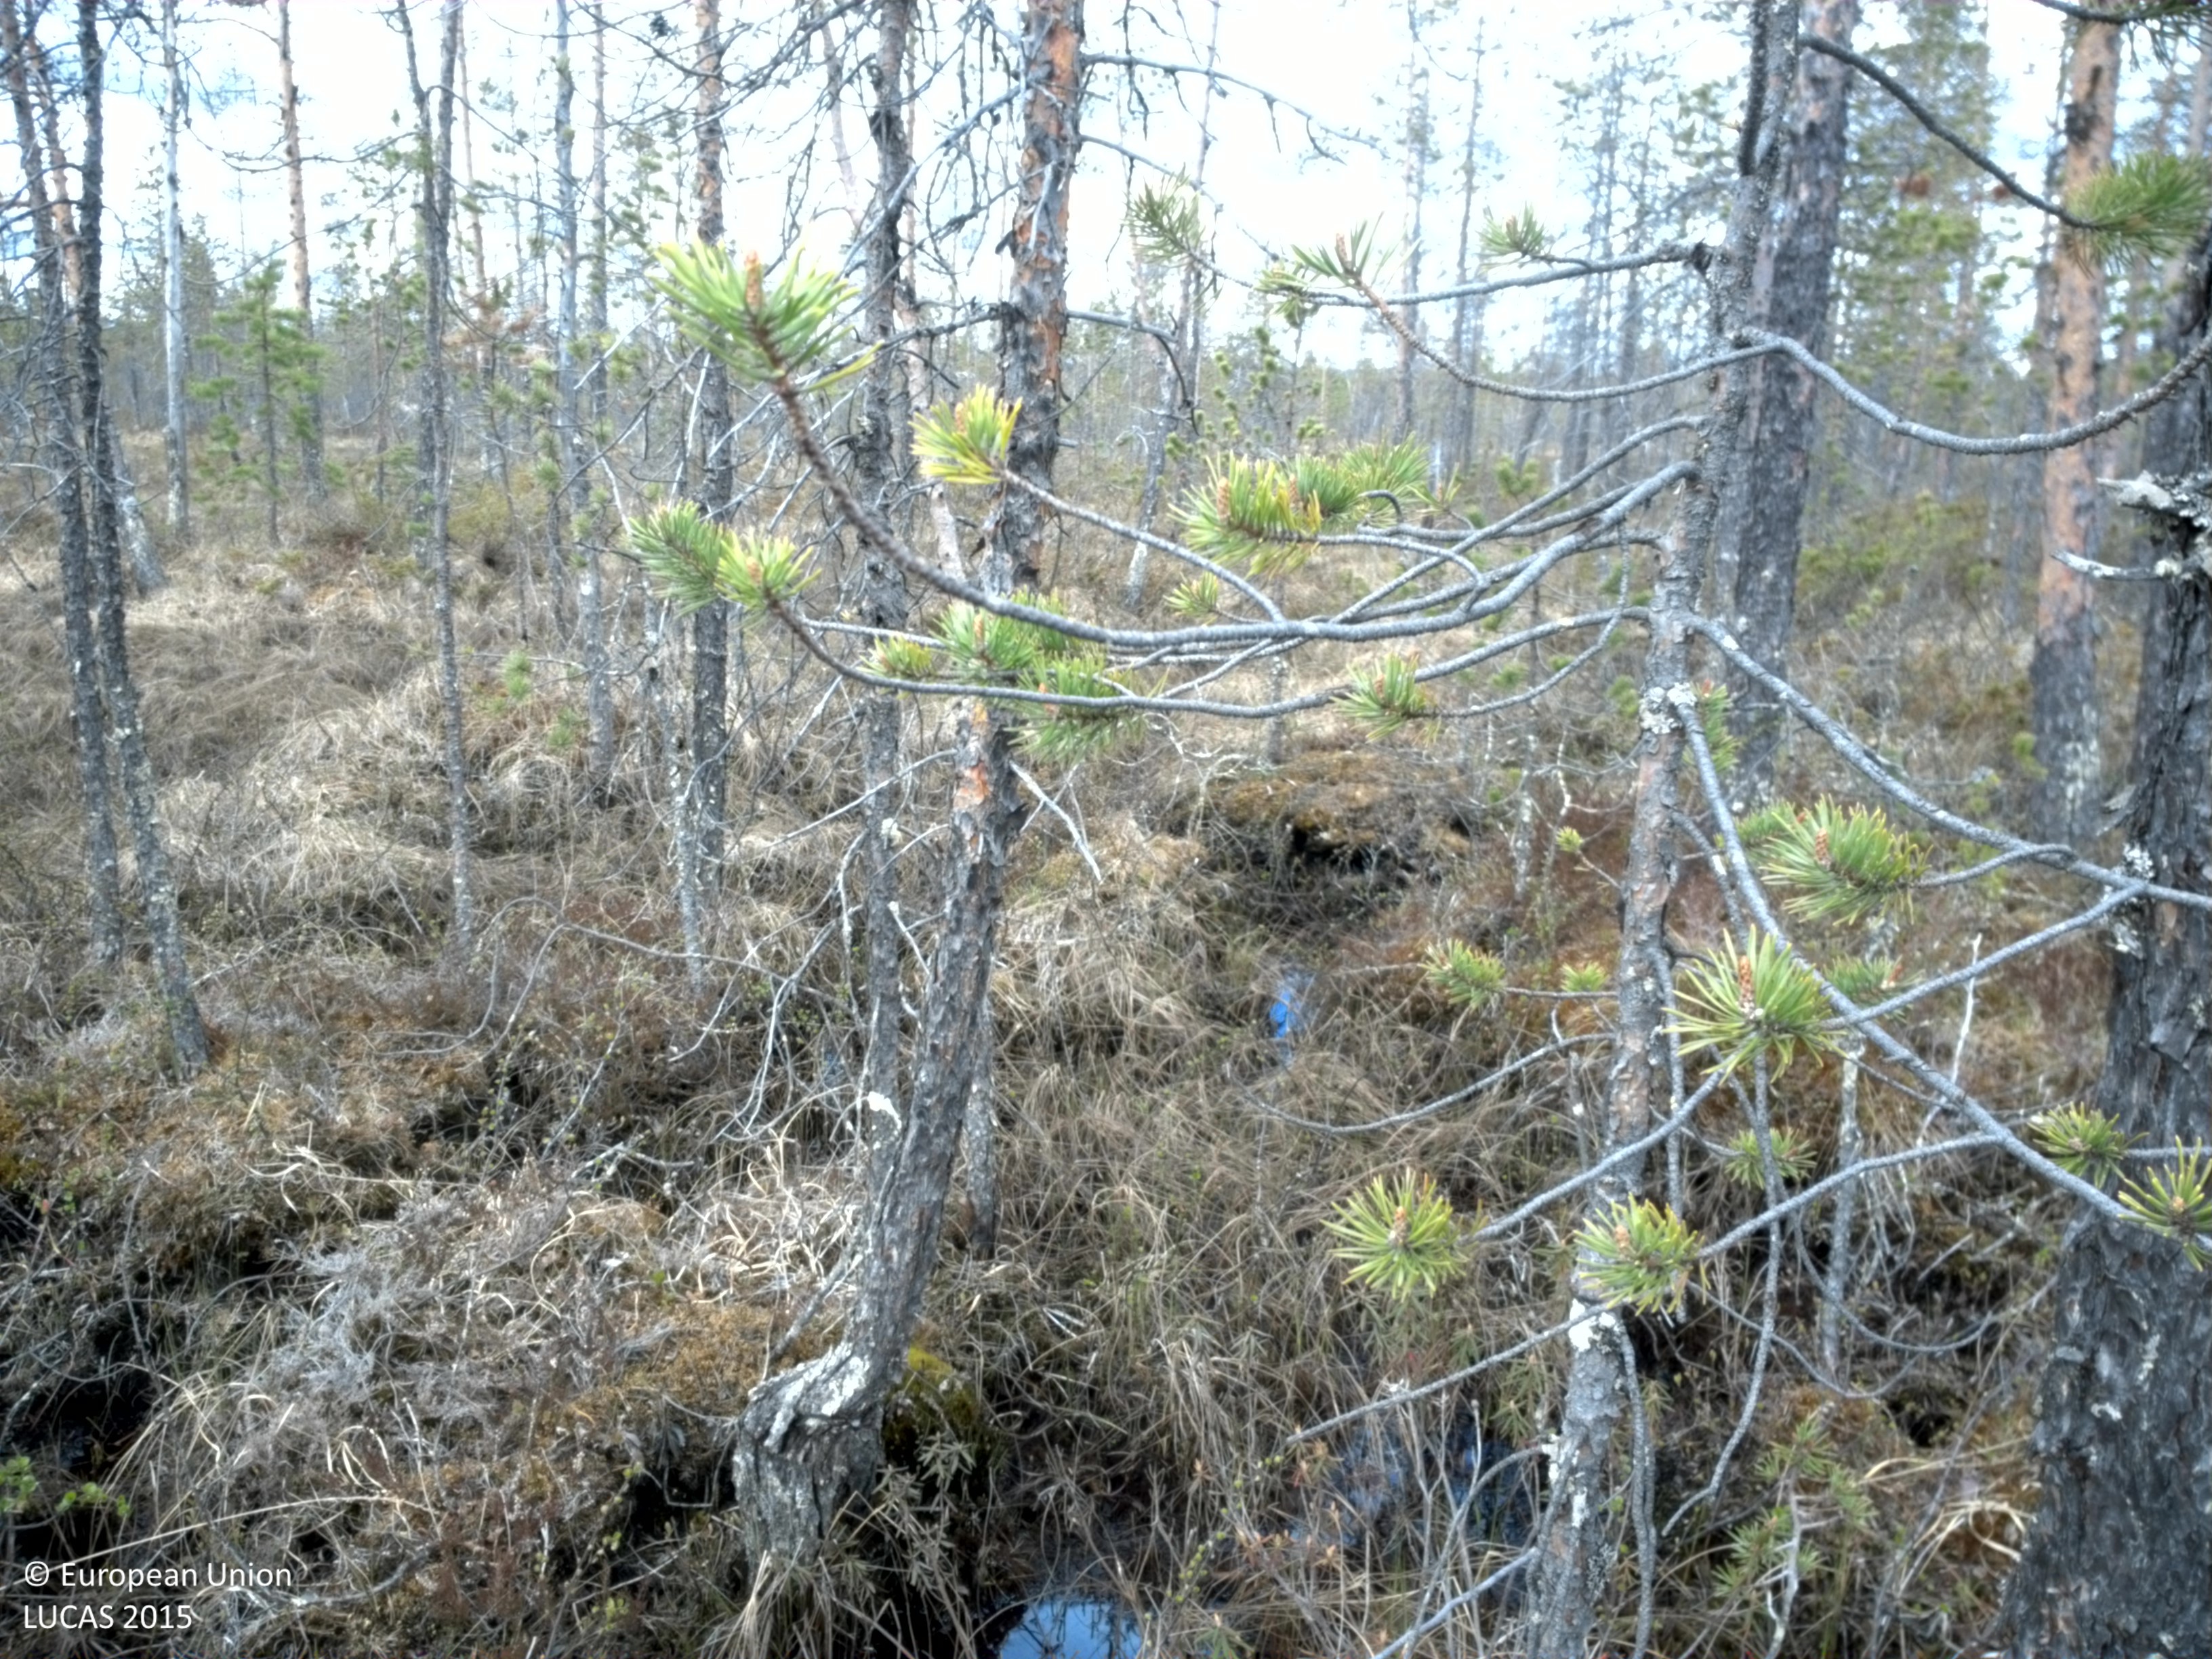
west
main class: Woodland
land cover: Pine dominated coniferous woodland
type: boreal forest
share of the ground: 25 - 50 %
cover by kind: shrubs 35 %, herbaceous plants 35 %, coniferous forest trees 25 %, lichens and mosses 5 %
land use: Forestry
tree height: > 5 m
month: June
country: SE
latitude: 66.9954
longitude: 21.3054
